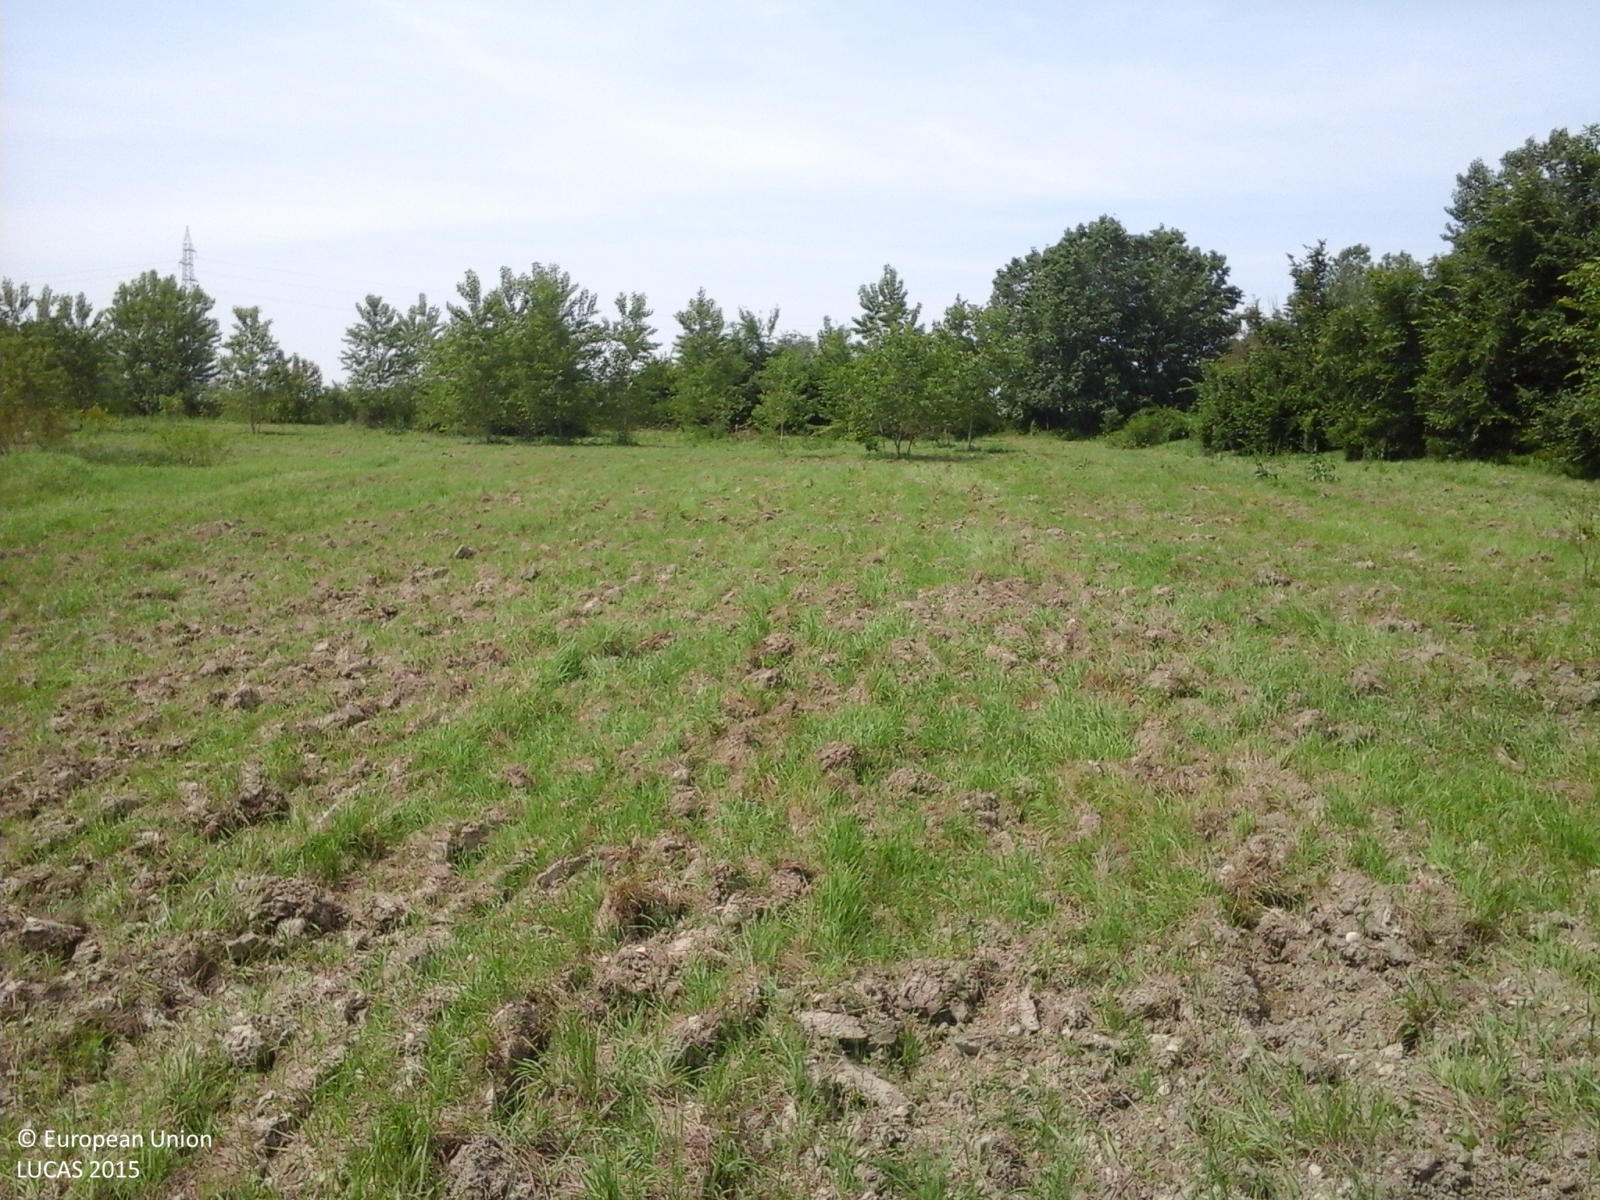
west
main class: Grassland
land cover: Spontaneously vegetated surfaces
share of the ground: 50 - 75 %
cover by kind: herbaceous plants 55 %, unconsolidated bare surface 45 %
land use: Fallow land
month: May
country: IT
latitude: 44.9077
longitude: 10.6194
